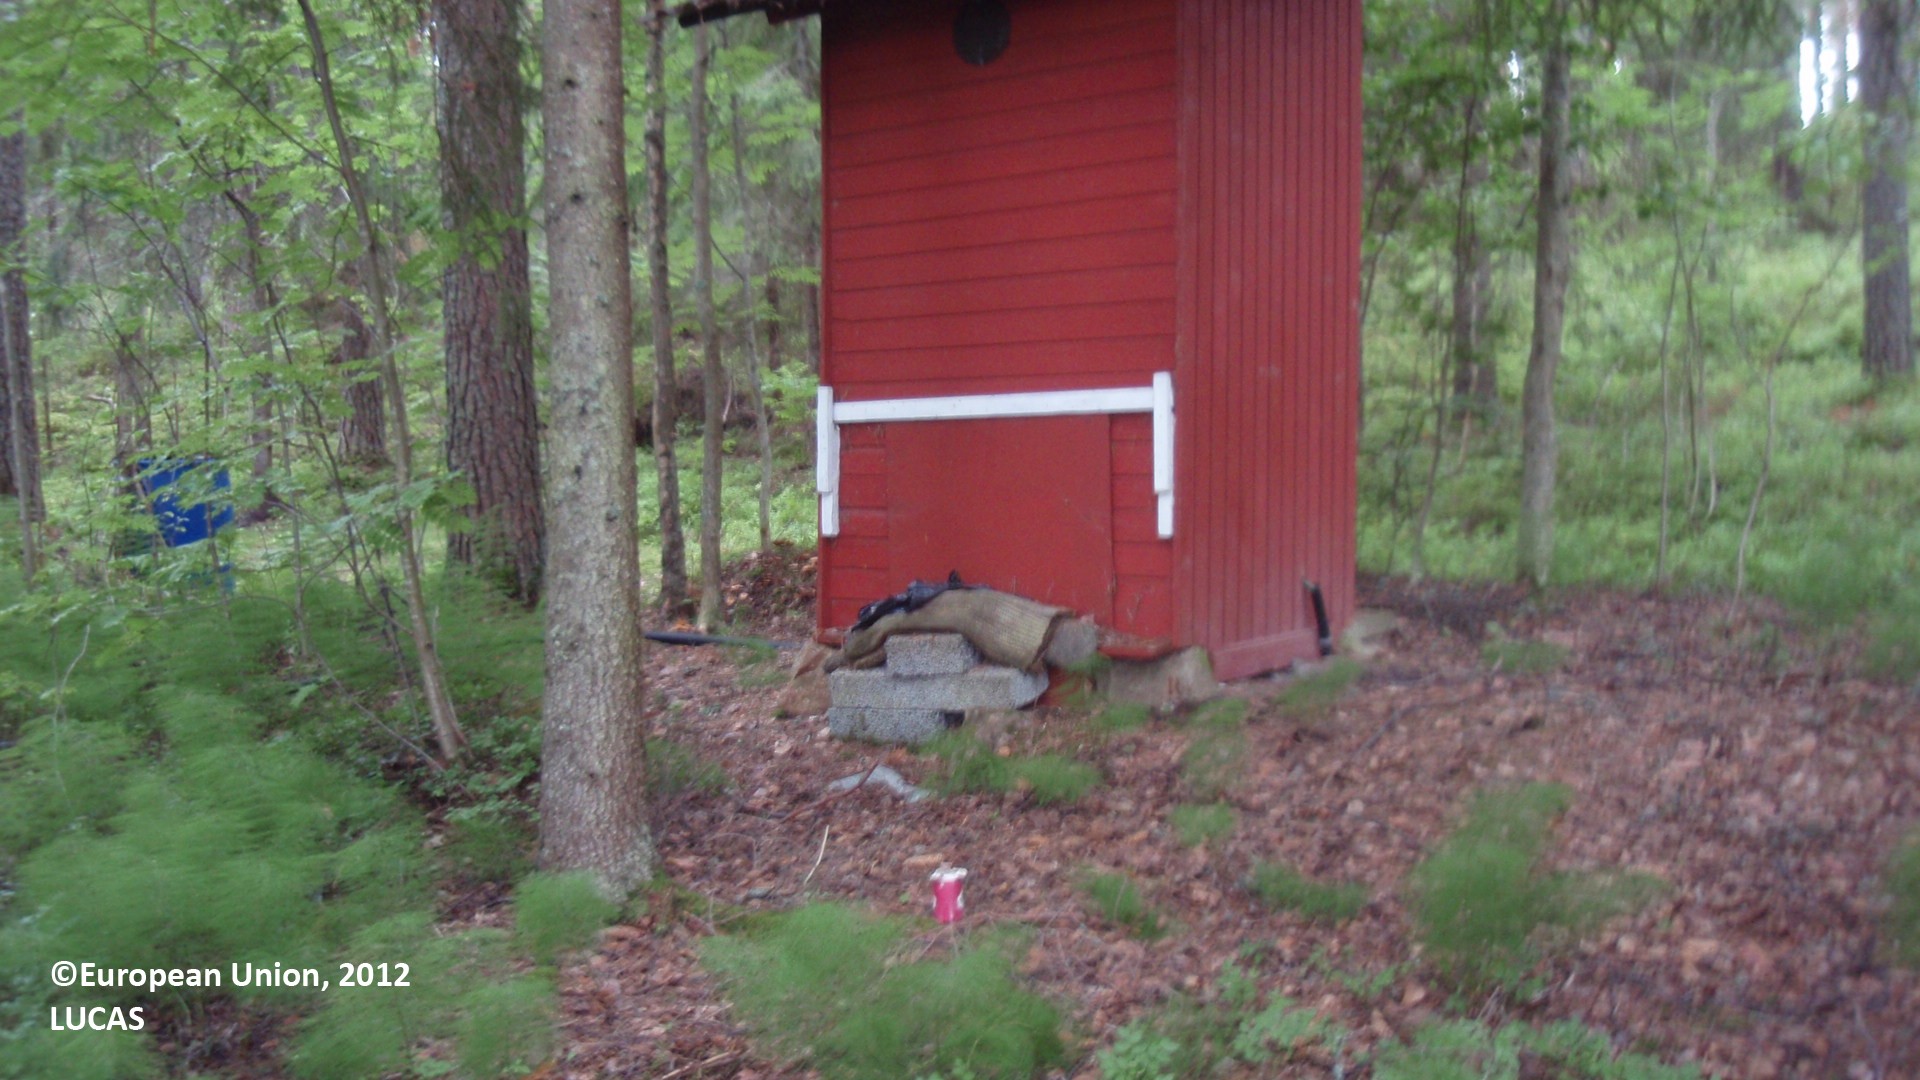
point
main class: Woodland
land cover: Other coniferous woodland
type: boreal forest
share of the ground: 50 - 75 %
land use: Forestry
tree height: > 5 m
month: August
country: FI
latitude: 60.9591
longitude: 26.9140
